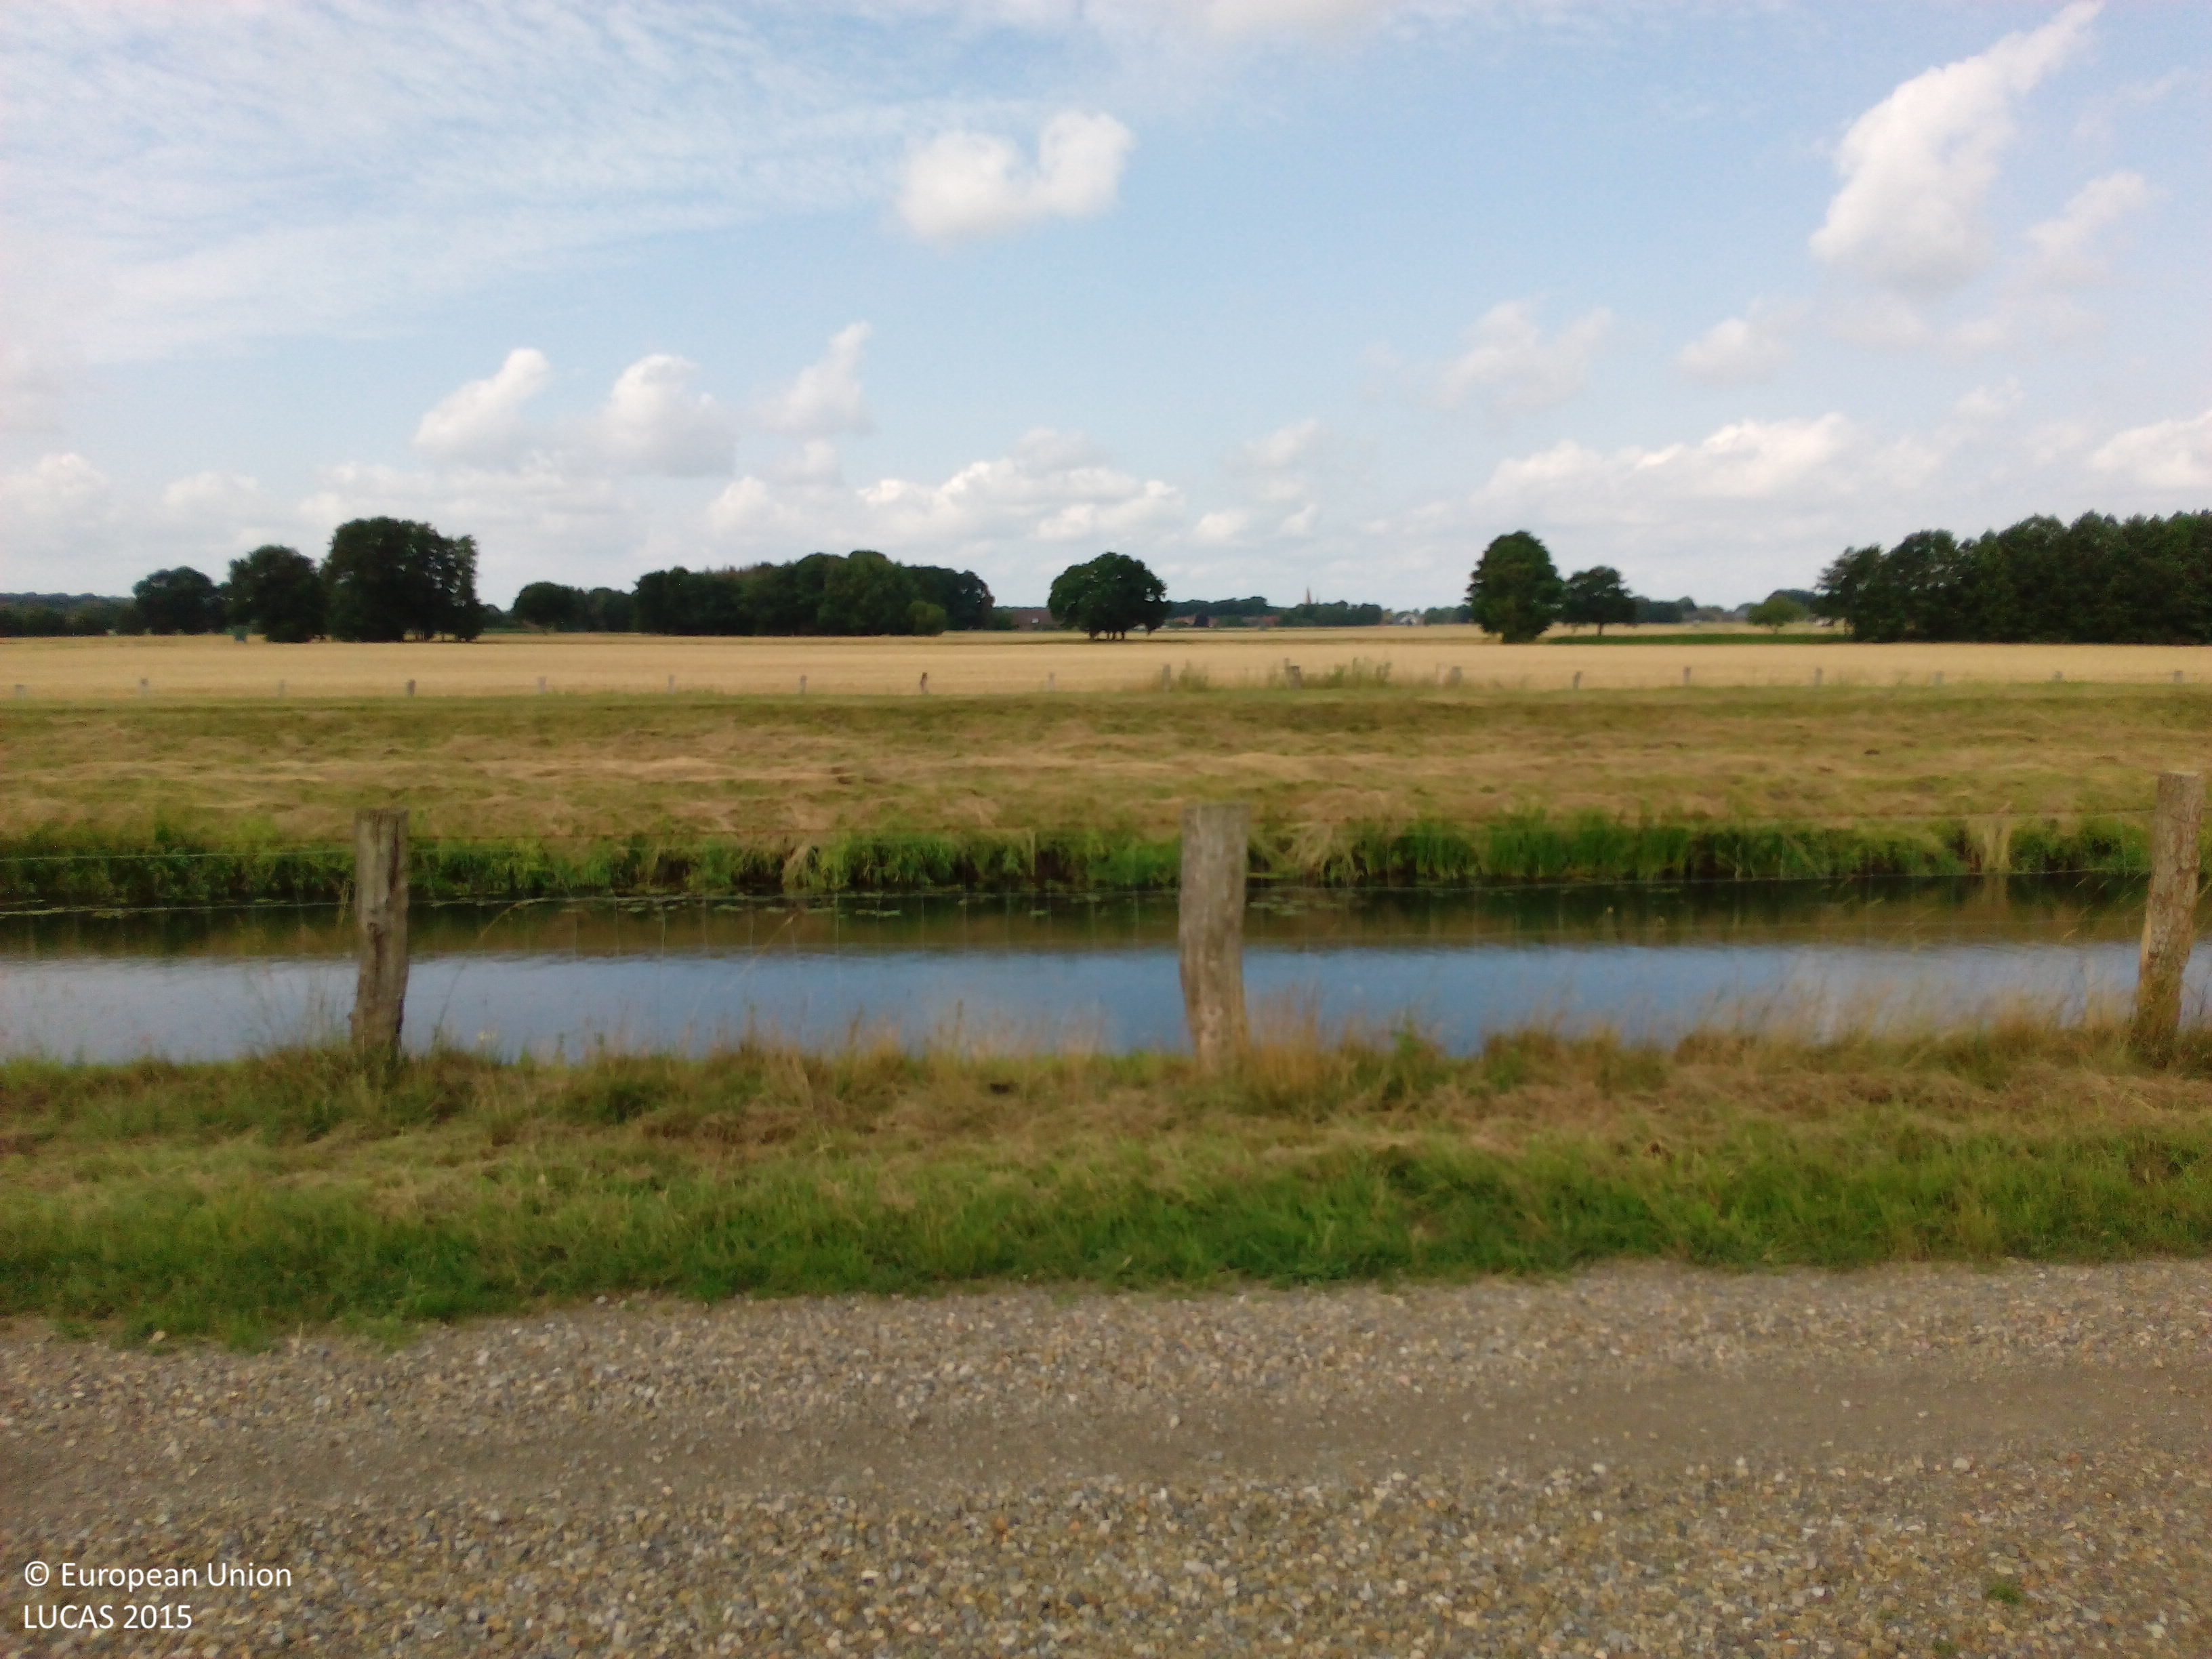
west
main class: Cropland
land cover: Common wheat
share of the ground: > 75 %
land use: Agriculture (excluding fallow land and kitchen gardens)
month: July
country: DE
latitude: 52.6304
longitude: 8.0059
